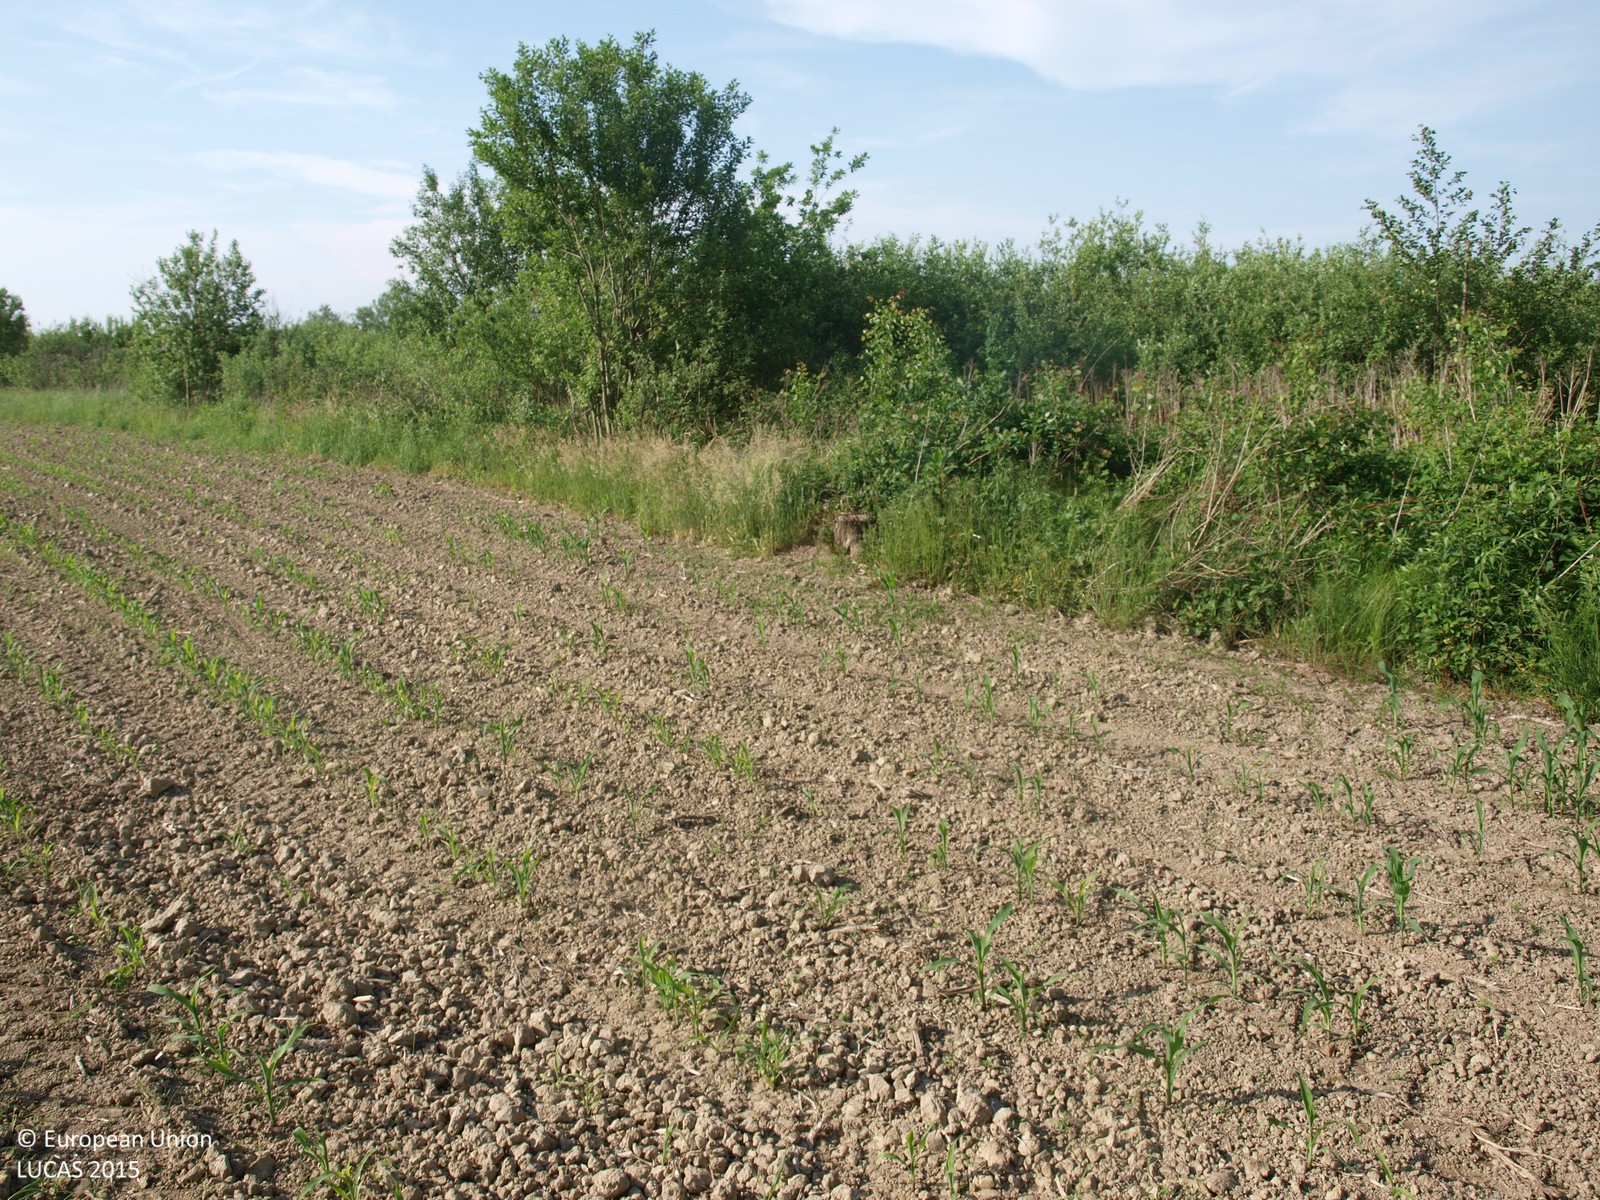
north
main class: Cropland
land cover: Maize
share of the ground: 25 - 50 %
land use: Agriculture (excluding fallow land and kitchen gardens)
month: May
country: HR
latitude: 46.2608
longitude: 16.2140
